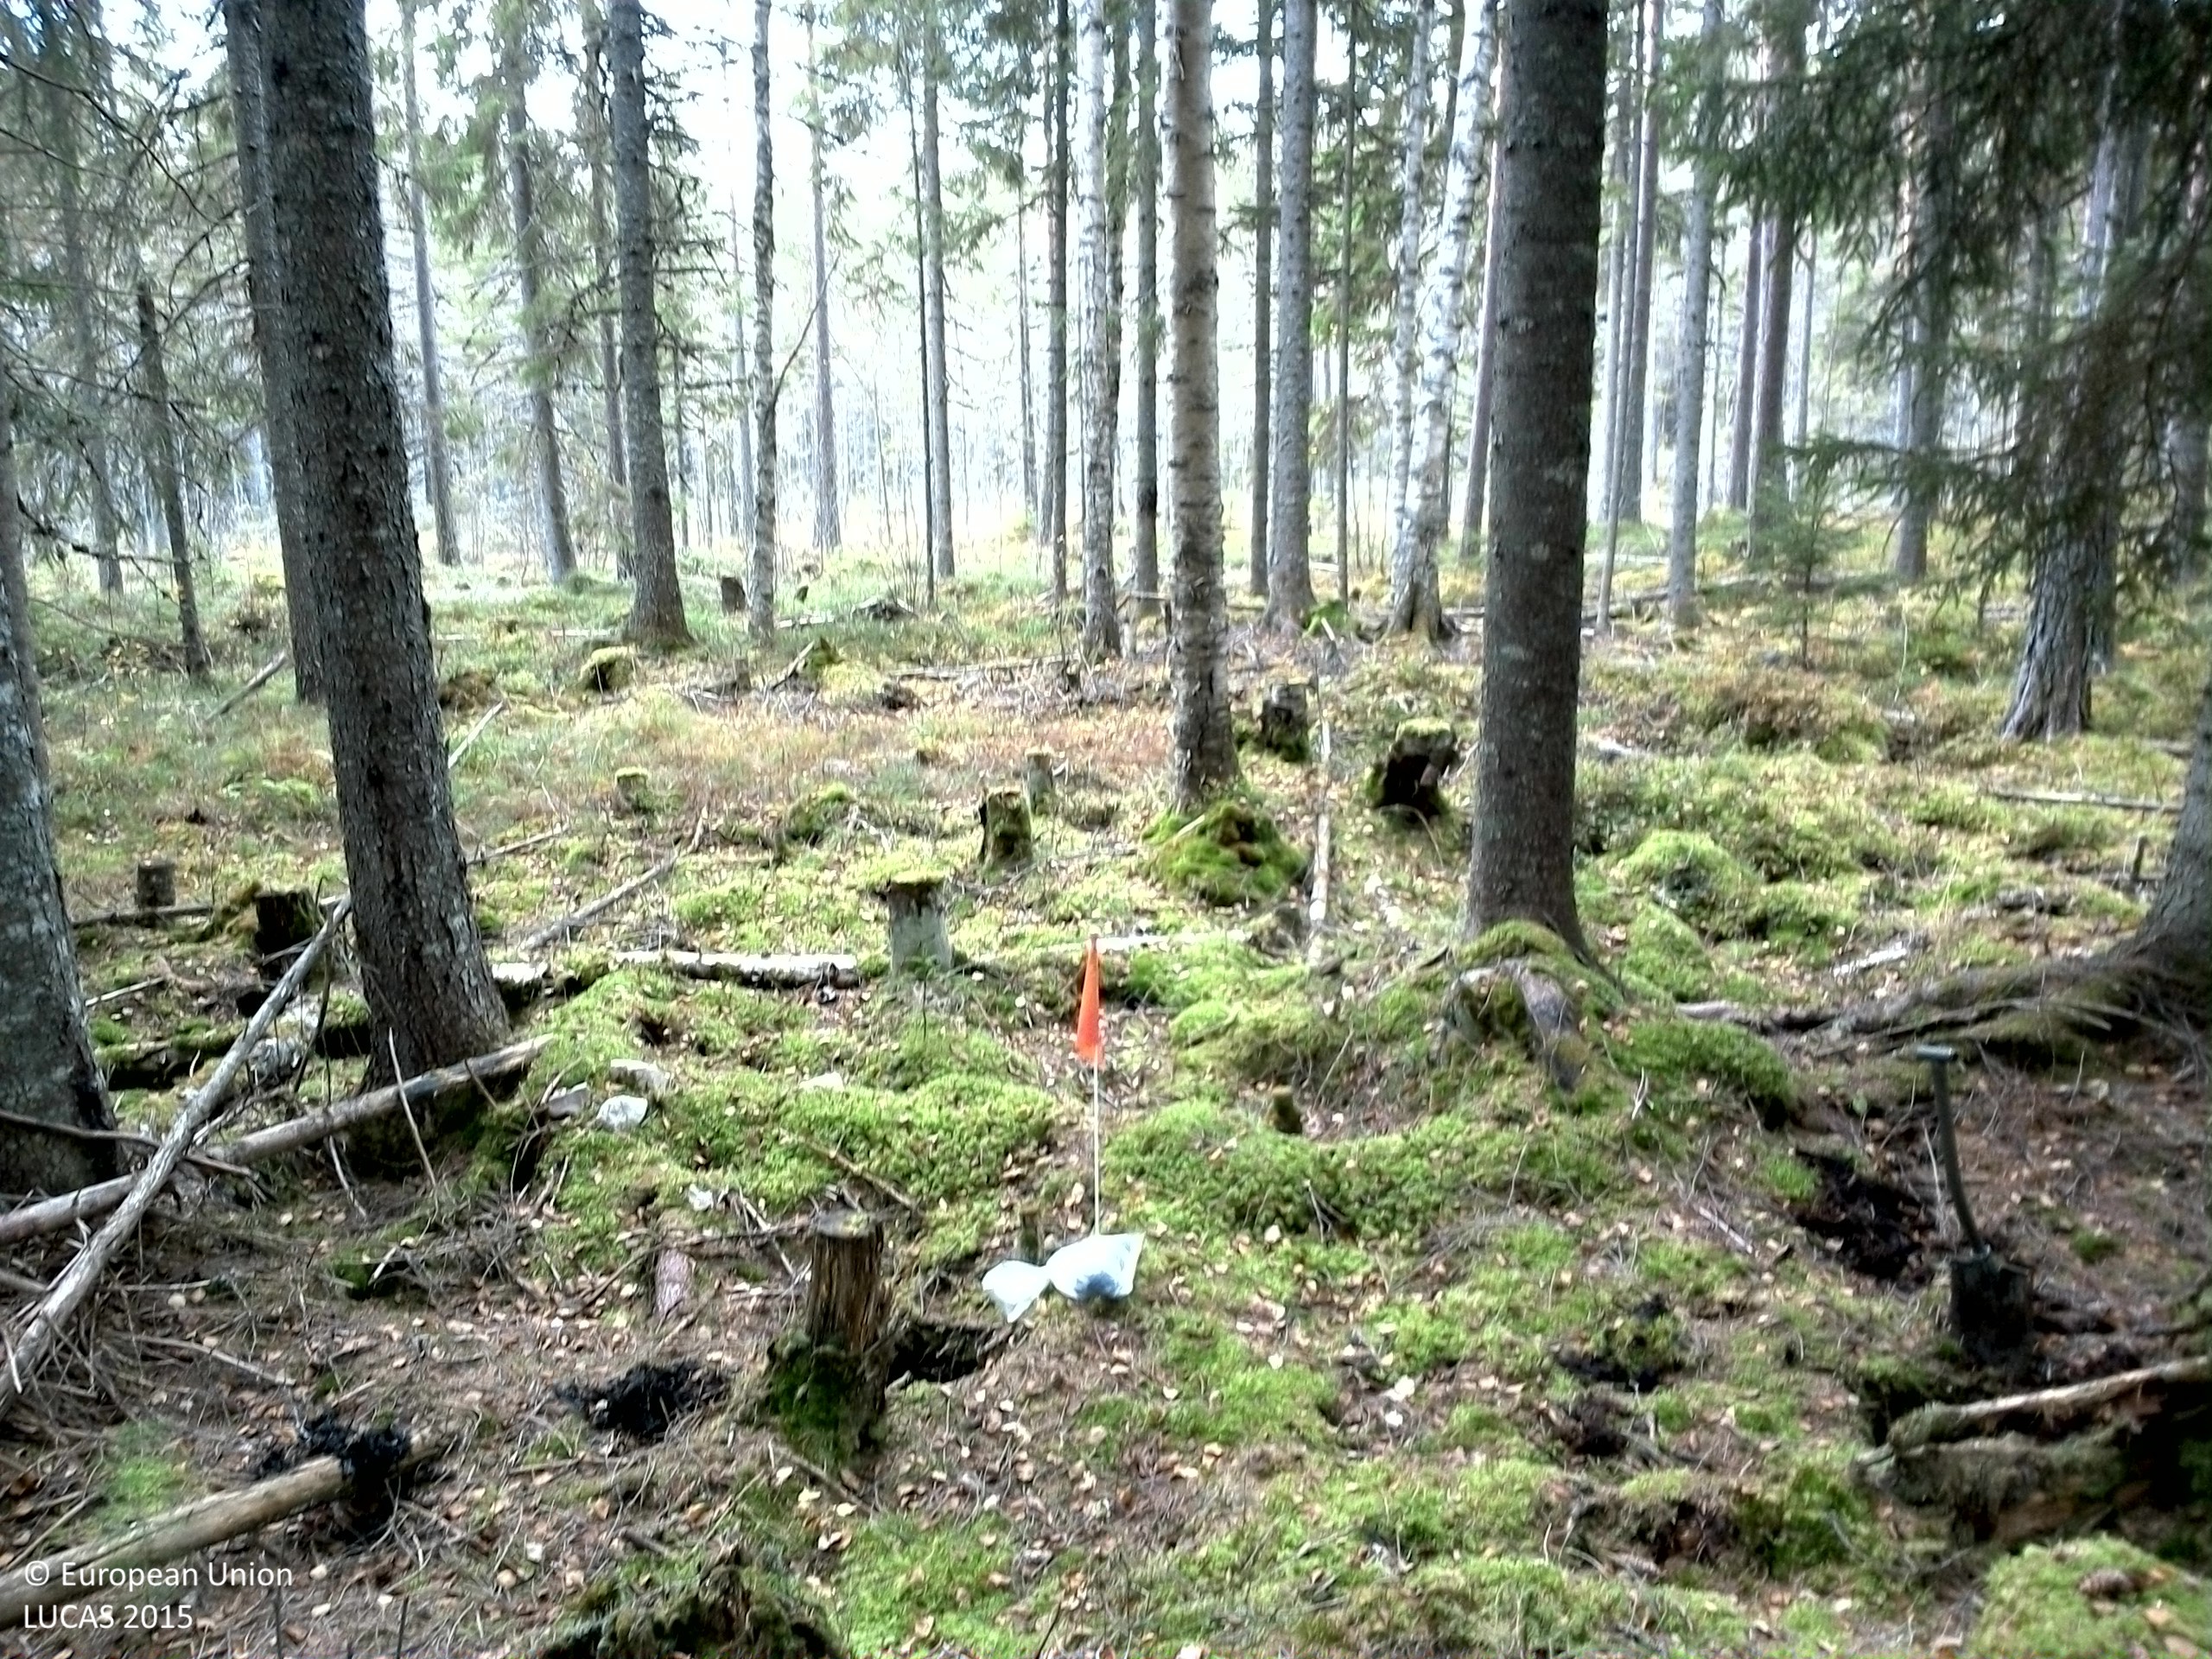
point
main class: Woodland
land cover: Spruce dominated mixed woodland
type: boreal forest
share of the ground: > 75 %
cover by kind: coniferous forest trees 55 %, broadleaved forest trees 20 %, lichens and mosses 15 %, shrubs 10 %
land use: Forestry
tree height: > 5 m
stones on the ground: < 10 %
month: October
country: SE
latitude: 61.2055
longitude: 14.6200
